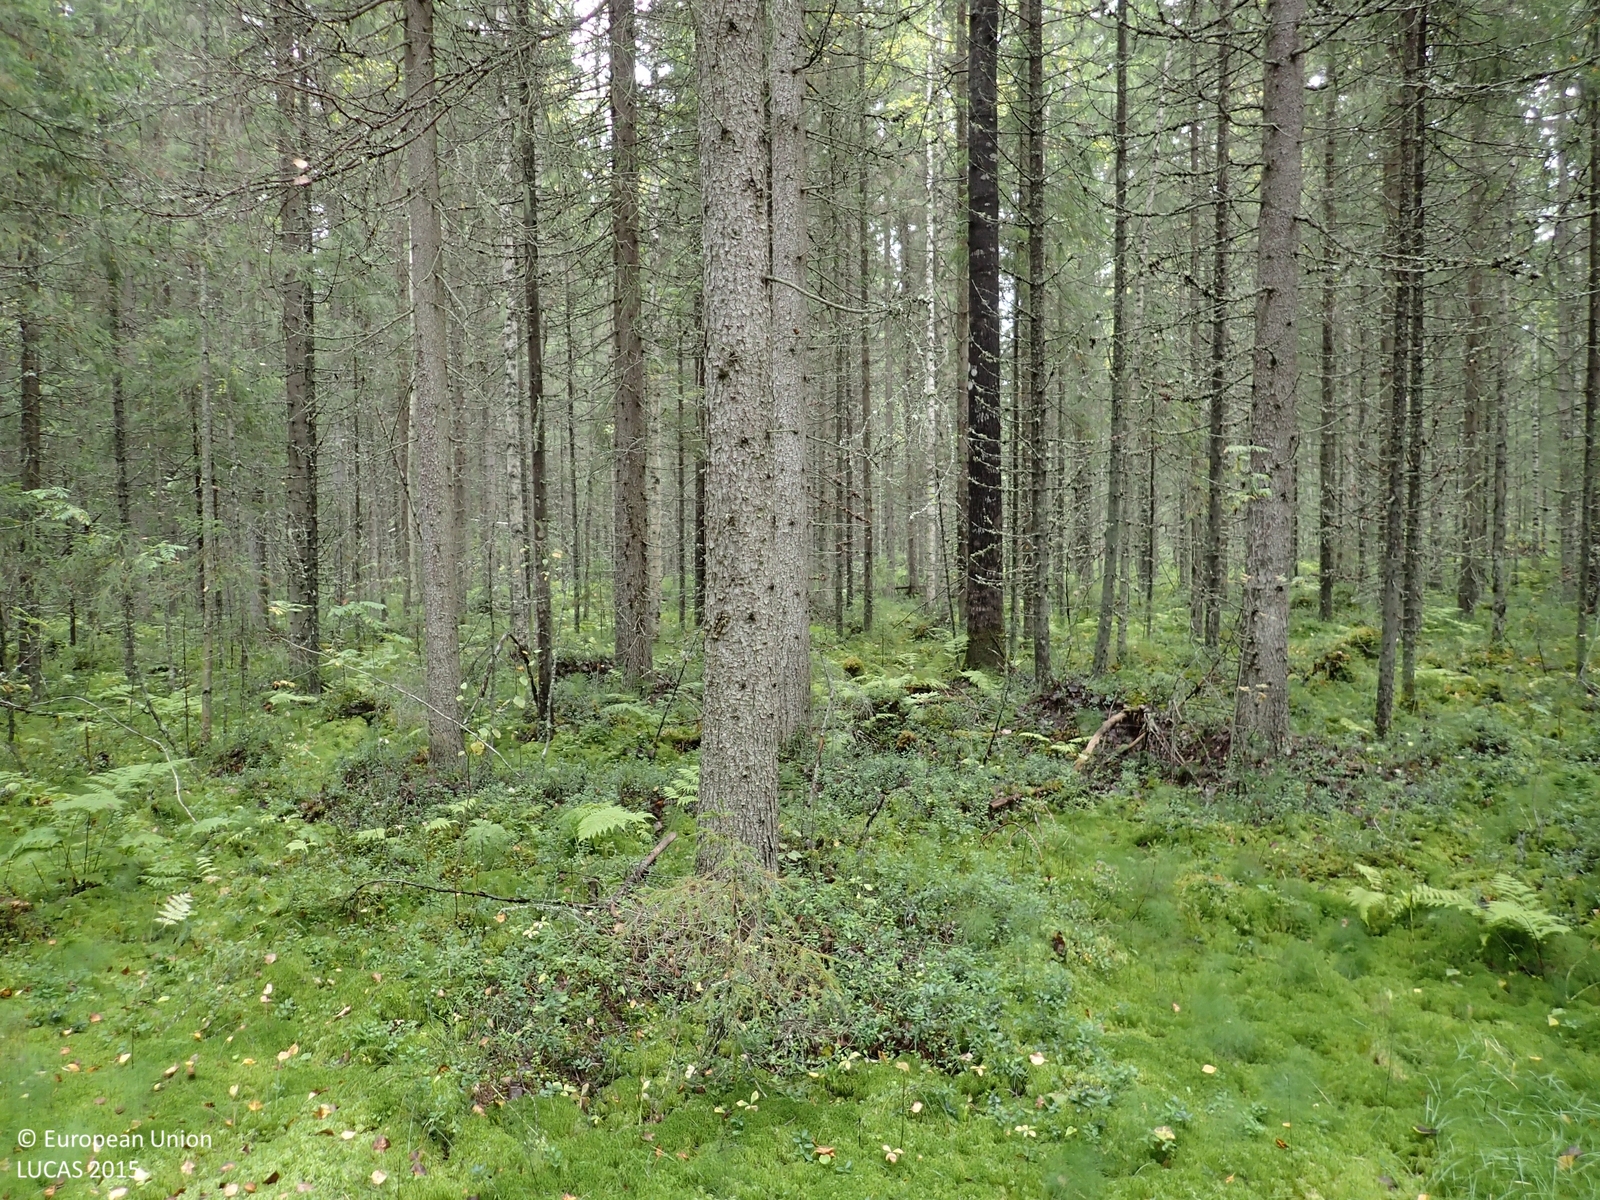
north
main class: Woodland
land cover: Spruce dominated coniferous woodland
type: mire and swamp forests
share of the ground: > 75 %
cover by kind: coniferous forest trees 65 %, broadleaved forest trees 10 %, shrubs 10 %, lichens and mosses 10 %, herbaceous plants 5 %
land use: Forestry
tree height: > 5 m
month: September
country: FI
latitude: 63.0988
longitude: 25.9858
